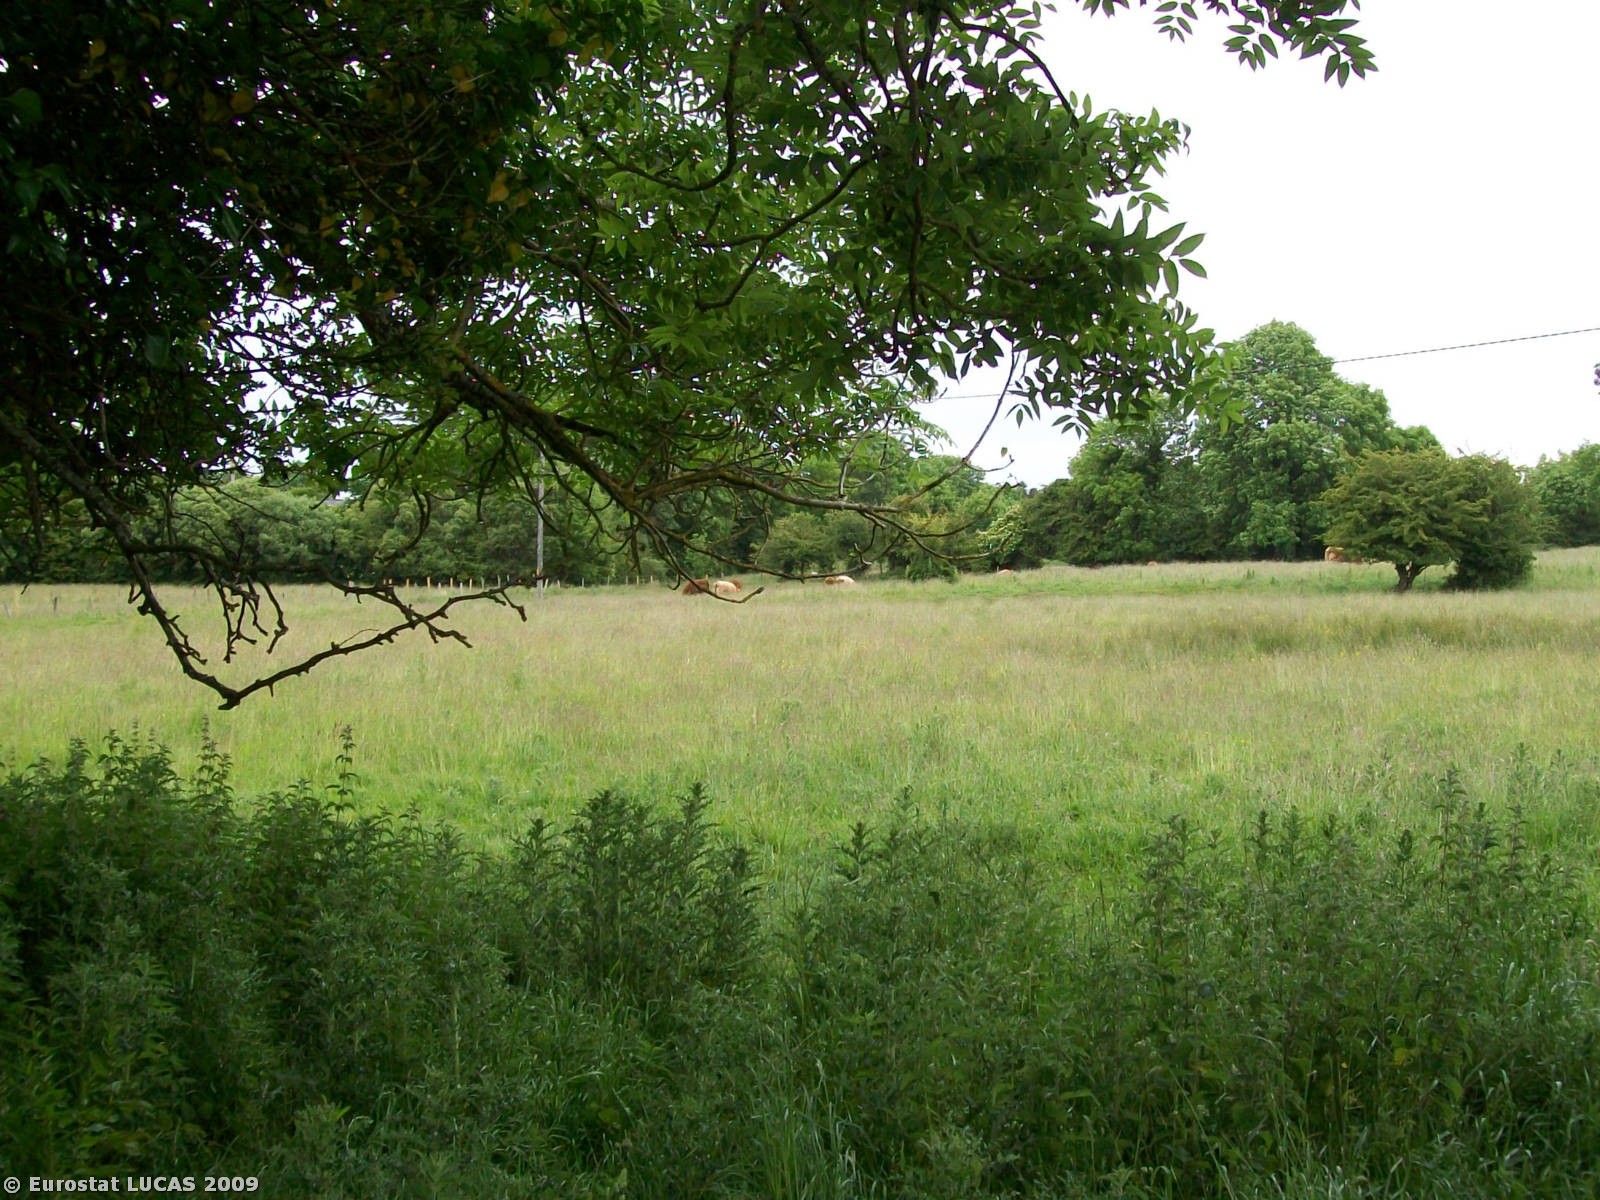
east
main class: Grassland
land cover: Grassland without tree/shrub cover
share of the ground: > 75 %
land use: Agriculture (excluding fallow land and kitchen gardens)
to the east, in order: Grassland without tree/shrub cover; Abandoned hedges; Grassland without tree/shrub cover; Electric lines; Grassland without tree/shrub cover; Abandoned hedges; Grassland without tree/shrub cover
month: June
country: IE
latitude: 53.1612
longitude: -8.4847
